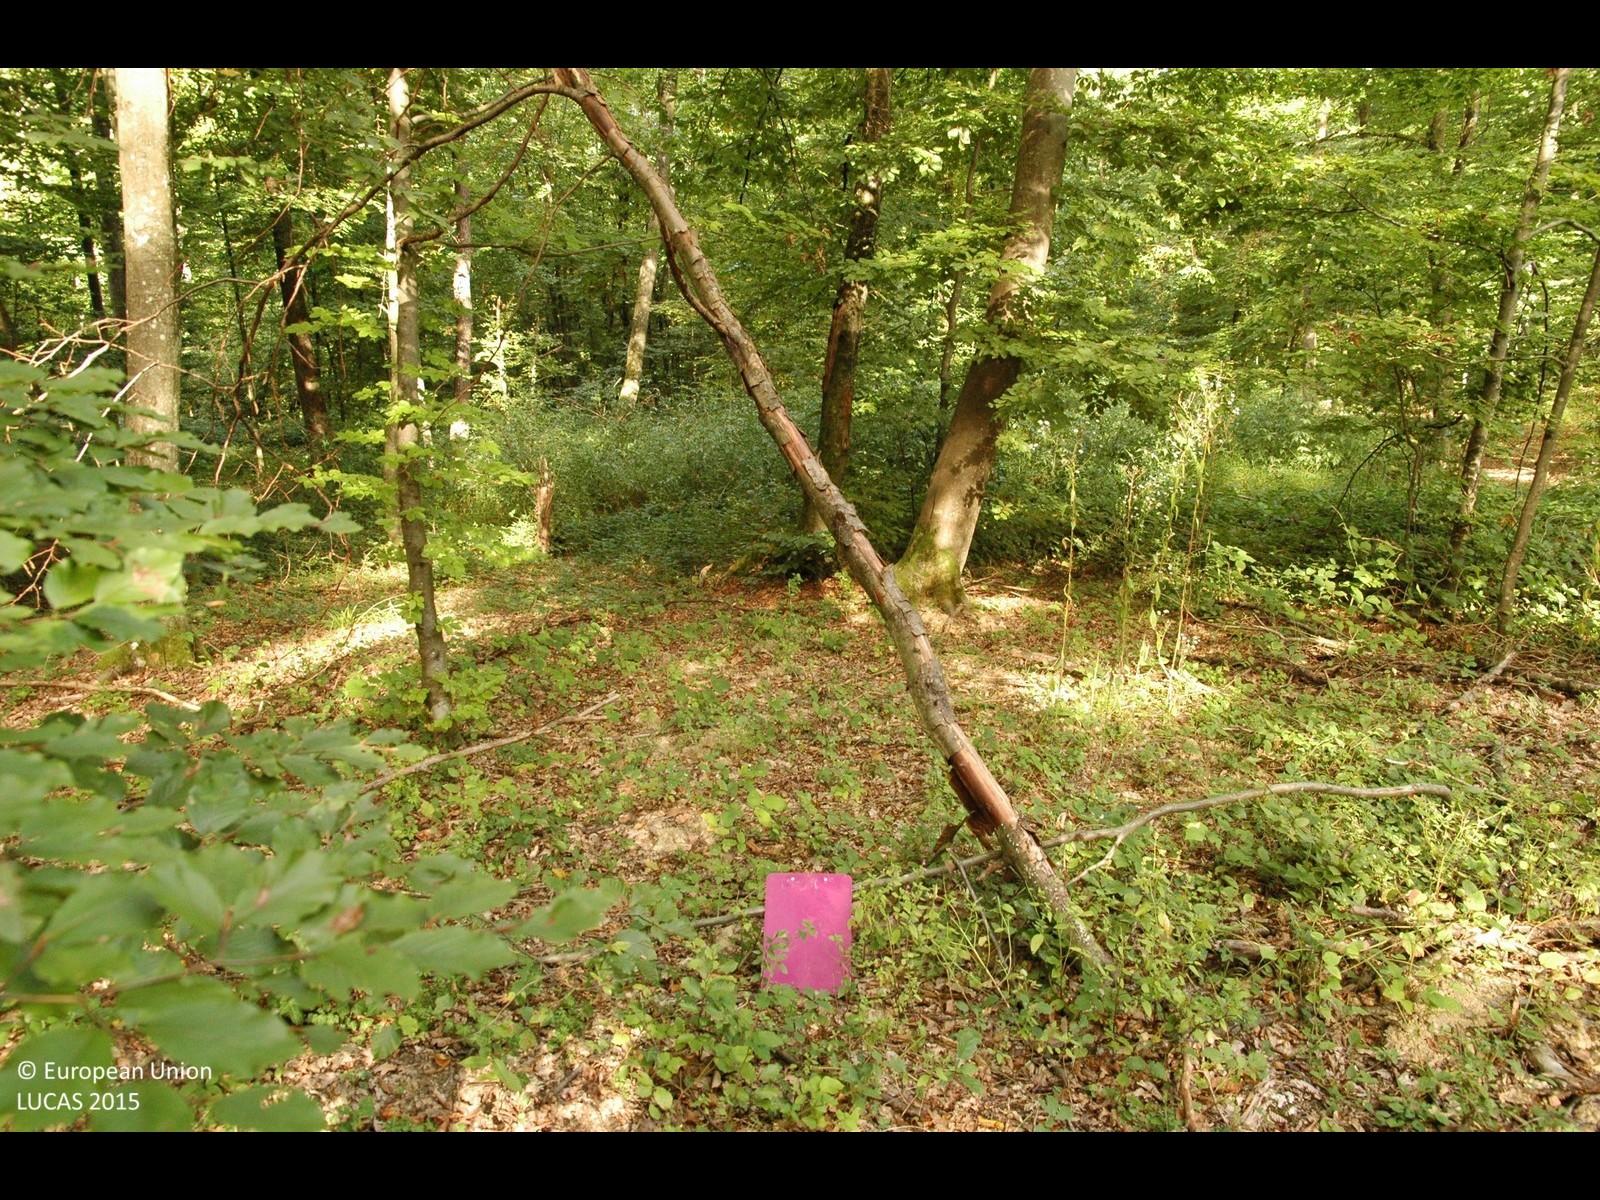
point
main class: Woodland
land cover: Broadleaved woodland
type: mesophytic deciduous forest
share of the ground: > 75 %
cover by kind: broadleaved forest trees 100 %
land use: Forestry
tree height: > 5 m
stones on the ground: < 10 %
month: September
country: HR
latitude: 45.6472
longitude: 15.8867
